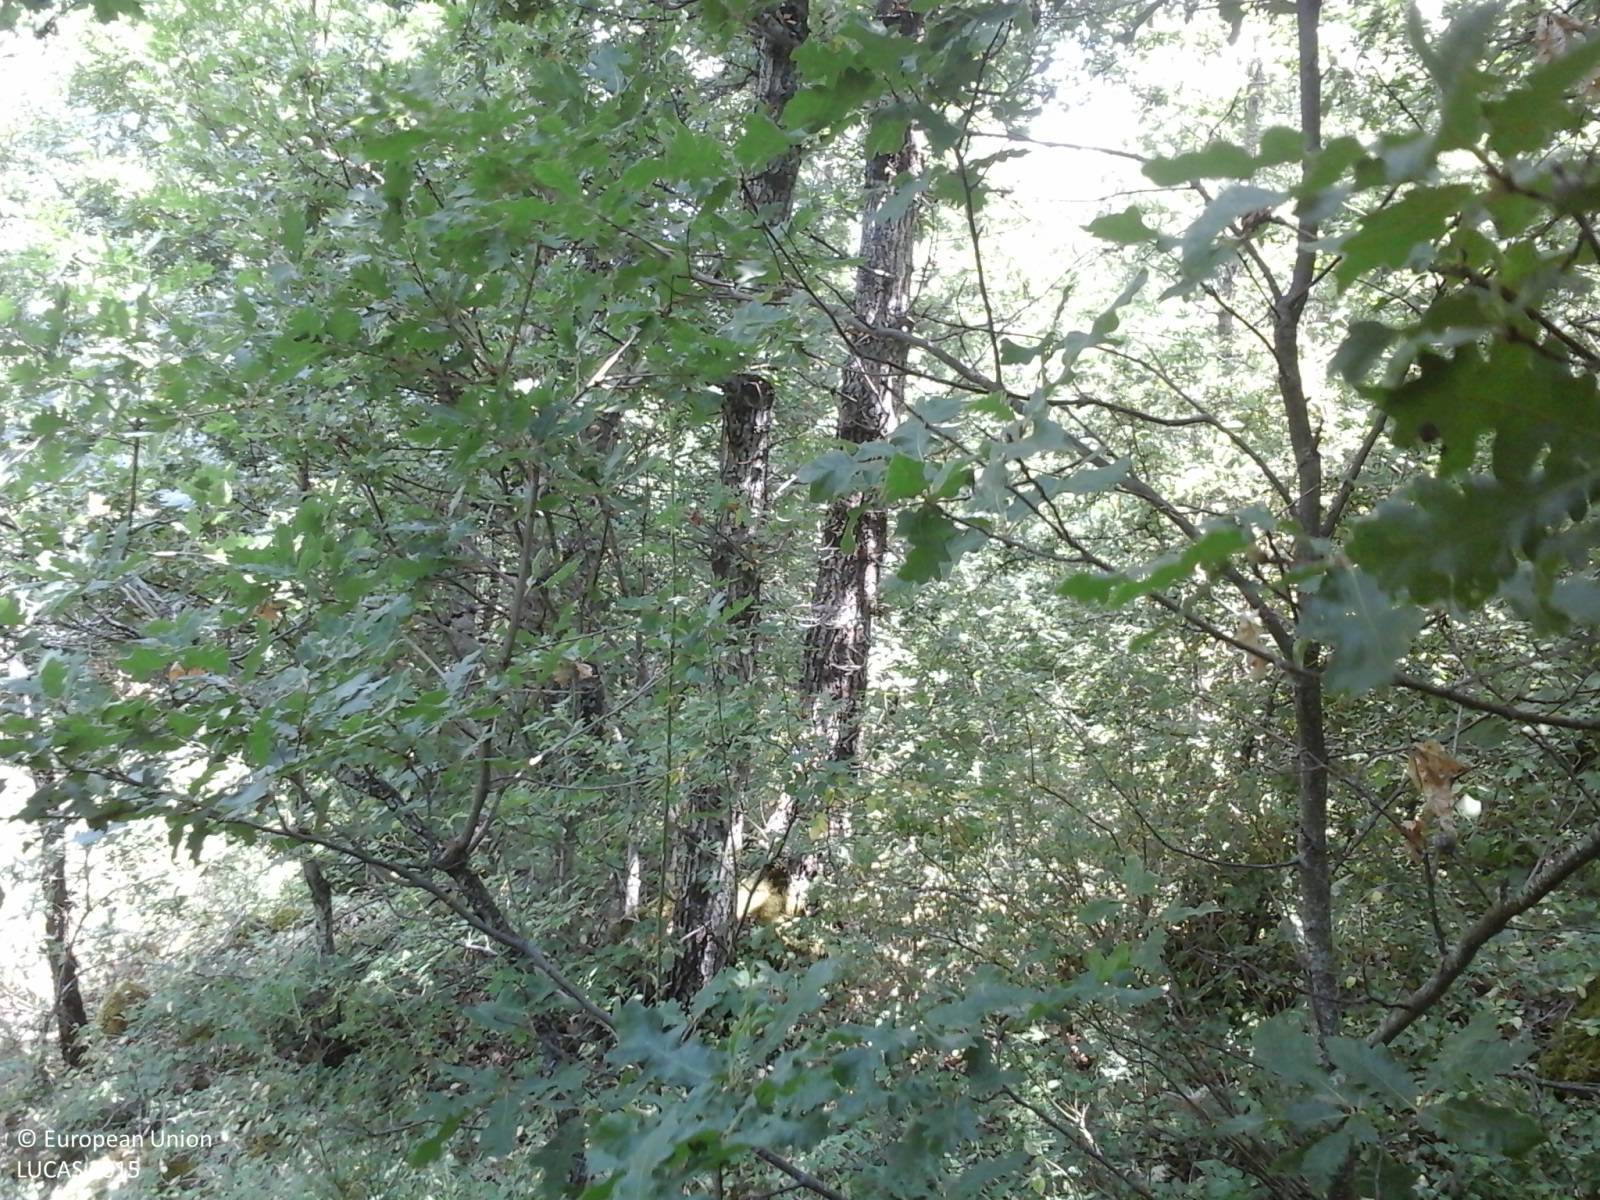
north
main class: Woodland
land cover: Broadleaved woodland
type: thermophilous deciduous forest
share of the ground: > 75 %
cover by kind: broadleaved forest trees 100 %
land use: Forestry
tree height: > 5 m
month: July
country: IT
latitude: 42.4397
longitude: 13.2355
